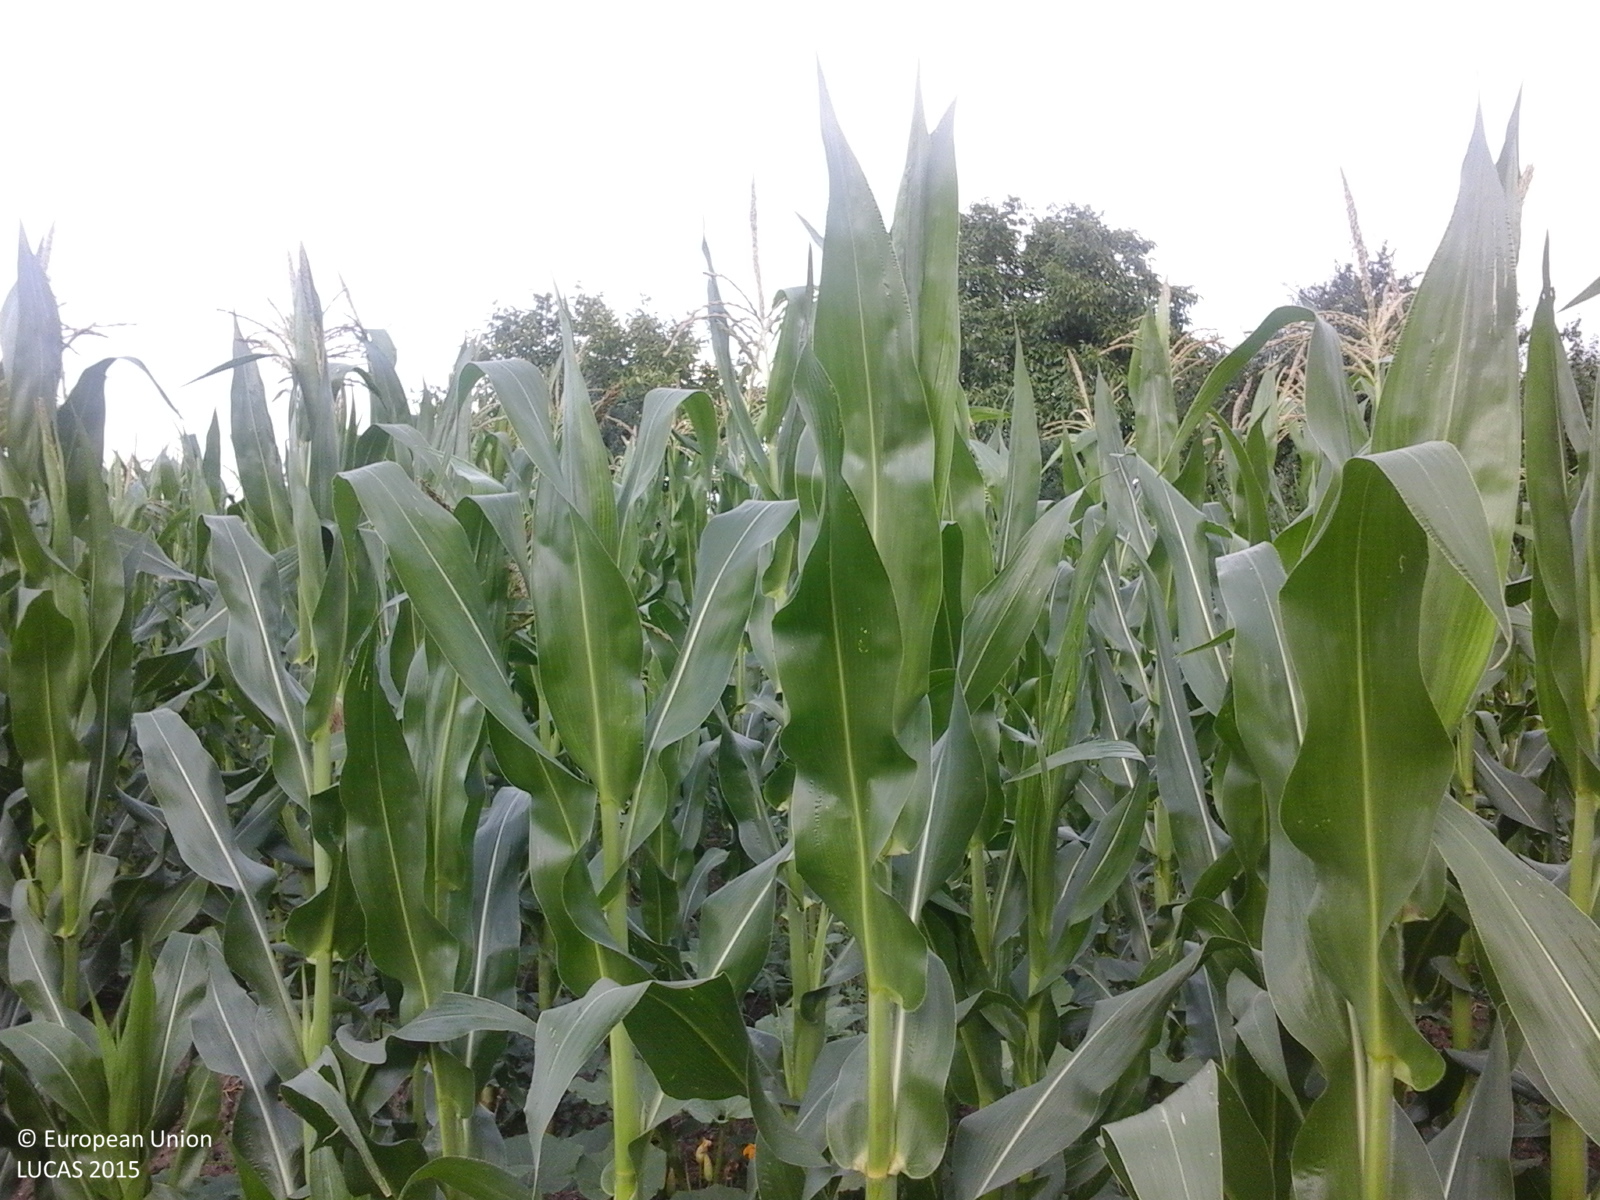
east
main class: Cropland
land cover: Maize
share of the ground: > 75 %
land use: Agriculture (excluding fallow land and kitchen gardens)
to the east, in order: Maize; Lucerne; Common wheat; Clovers; Maize; Oats; Grass margins; Tracks; Grass margins; Triticale; Temporary grasslands
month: June
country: RO
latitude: 44.3175
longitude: 26.1923
